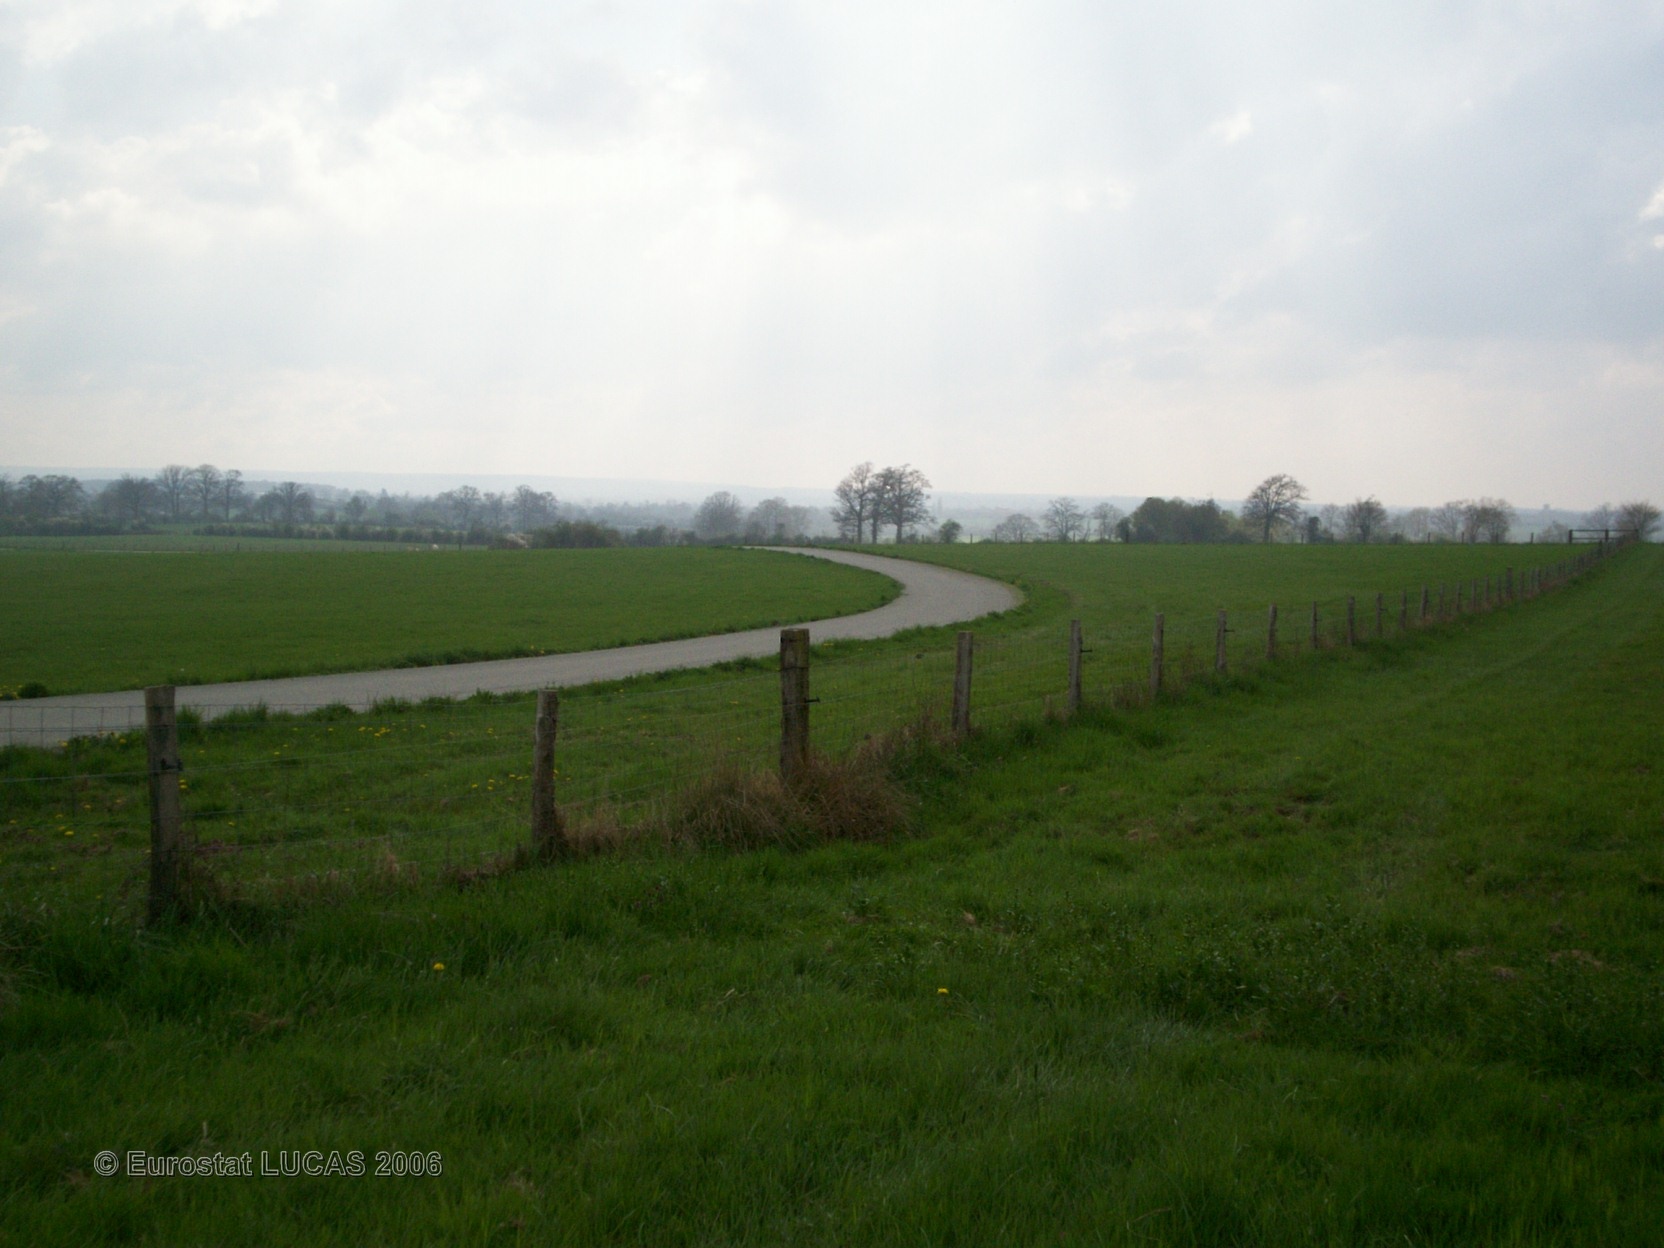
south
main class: Grassland
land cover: Grassland without tree/shrub cover
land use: Agriculture (excluding fallow land and kitchen gardens)
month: April
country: FR
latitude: 48.7055
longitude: 0.1467
